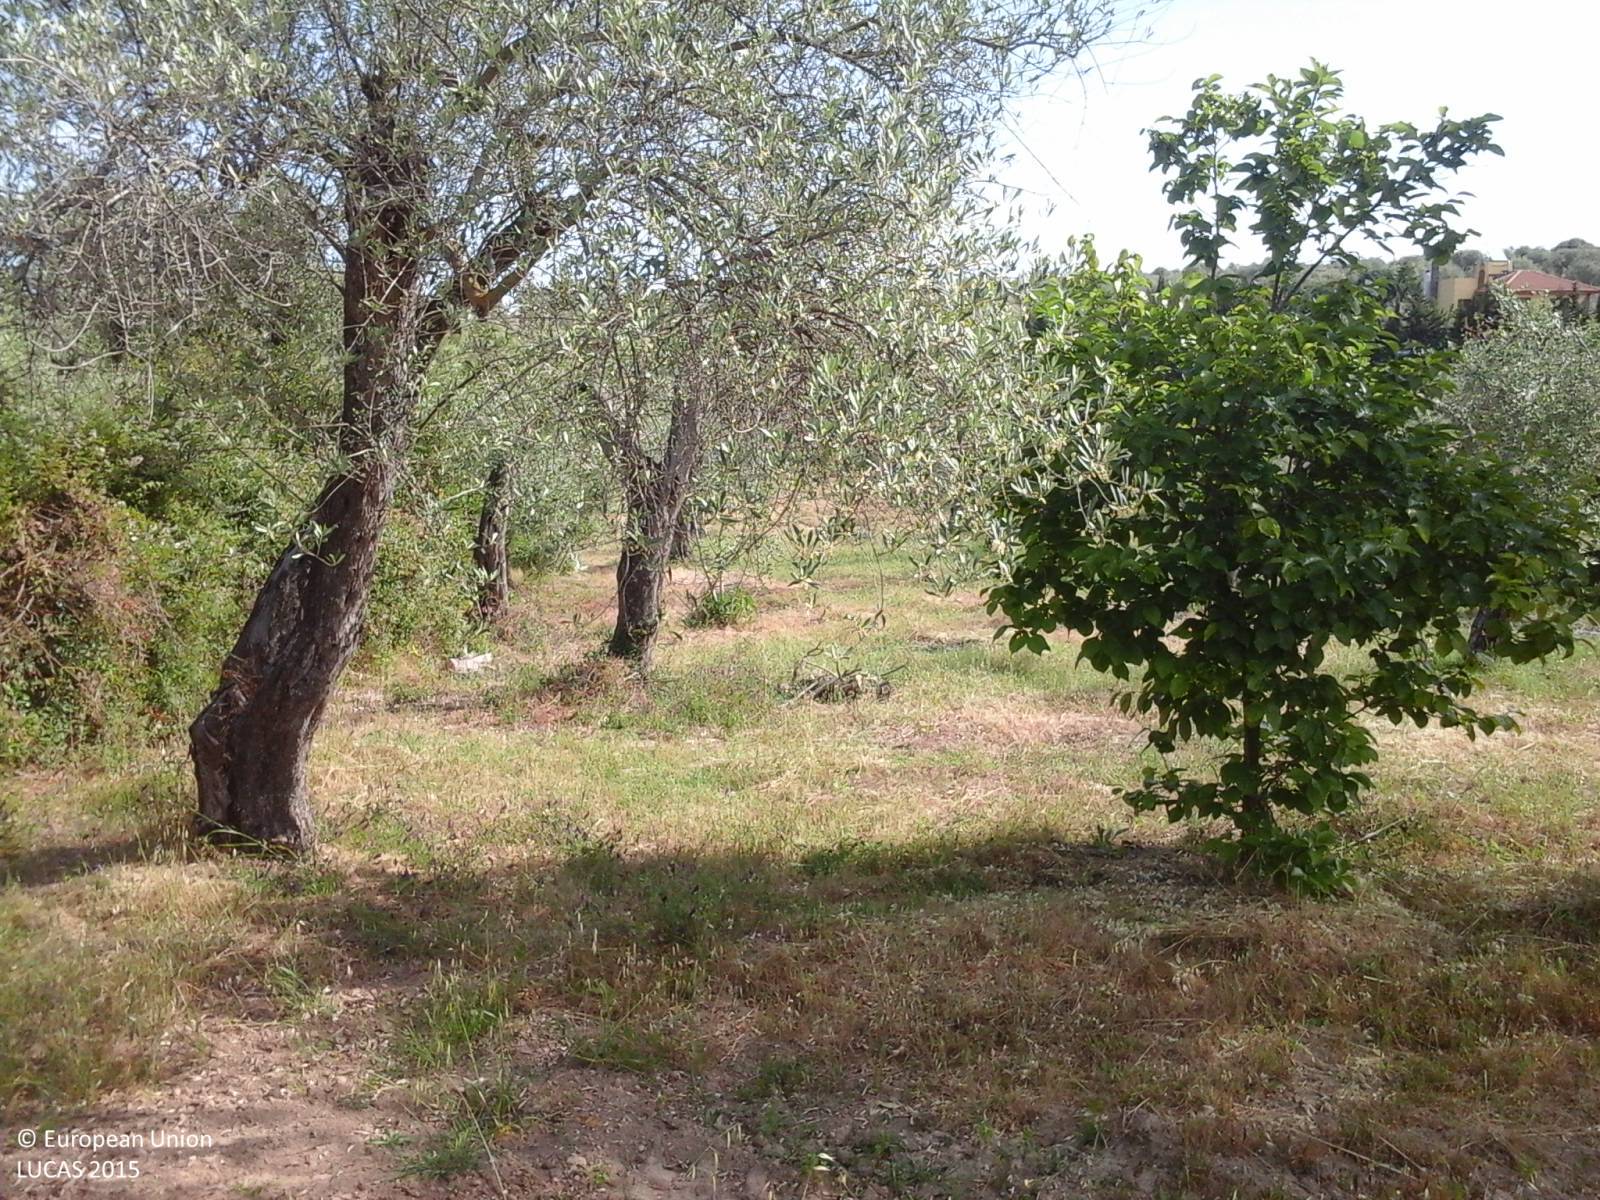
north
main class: Cropland
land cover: Olive groves
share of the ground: > 75 %
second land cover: Grassland without tree/shrub cover
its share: > 75 %
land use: Agriculture (excluding fallow land and kitchen gardens)
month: May
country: IT
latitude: 40.7638
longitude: 8.5734
